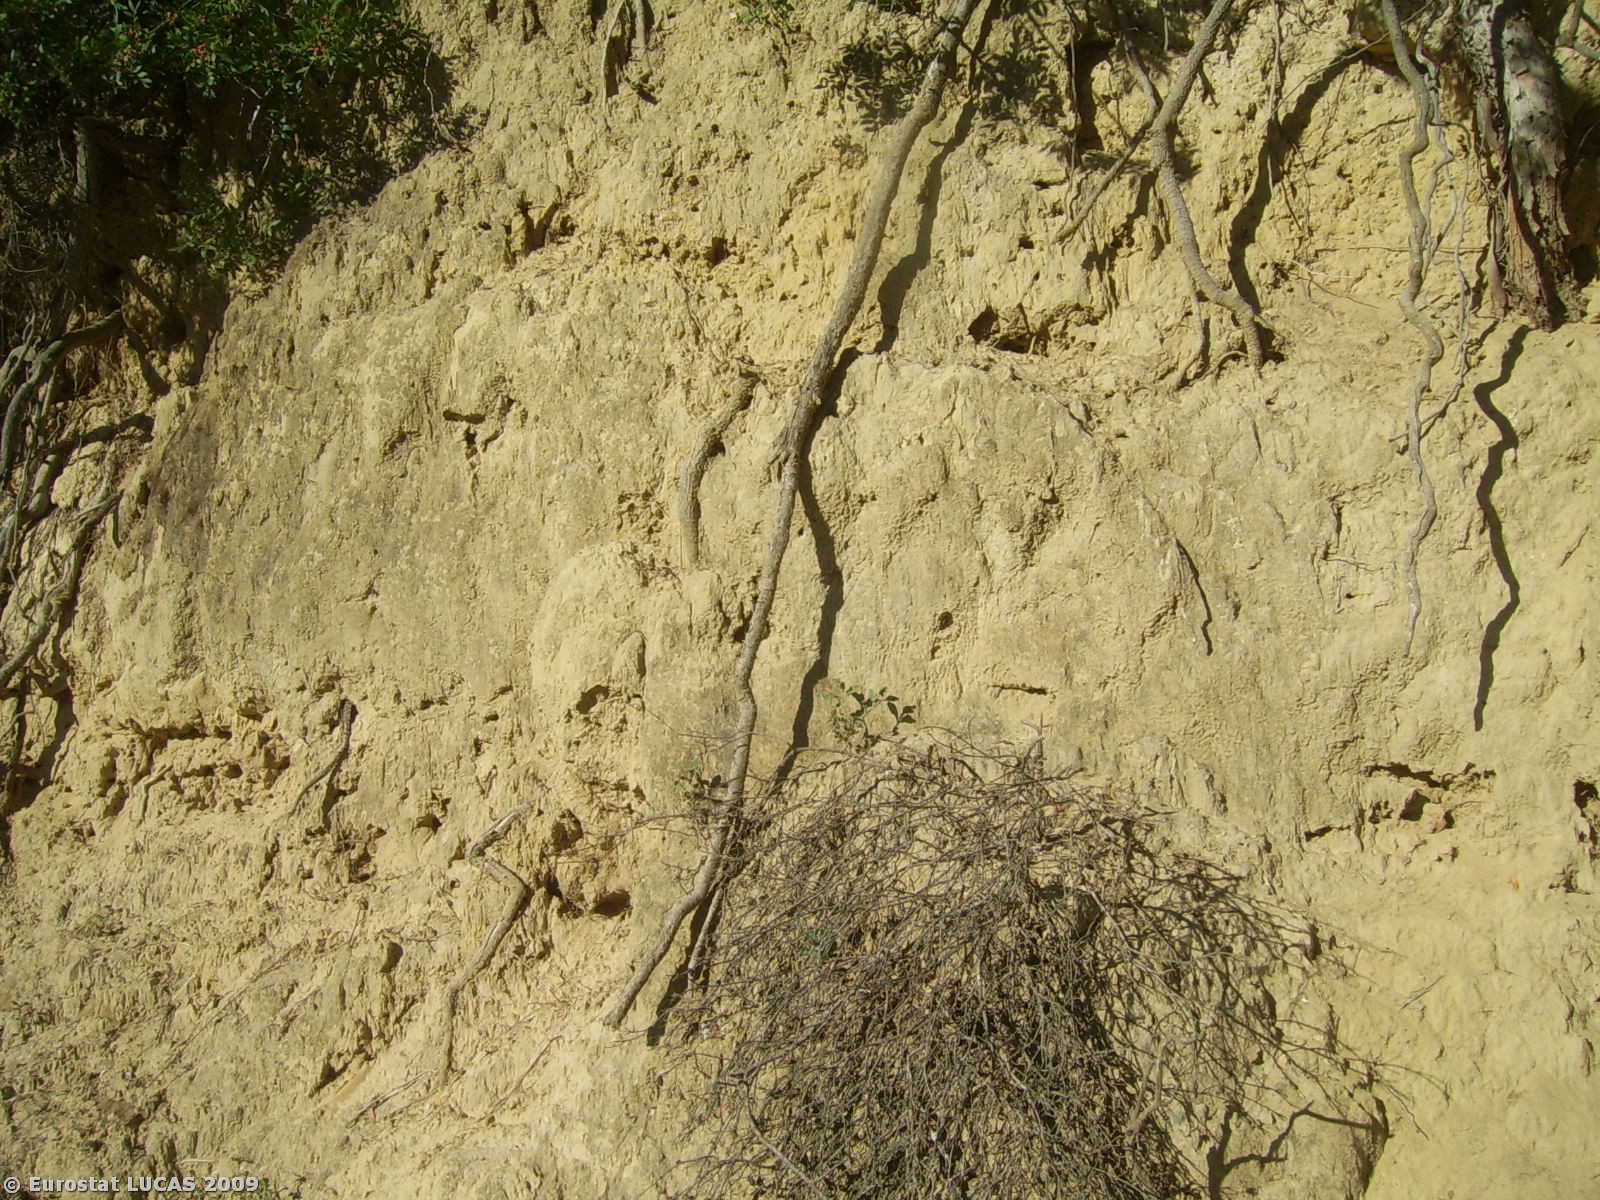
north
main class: Shrubland
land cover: Shrubland with sparse tree cover
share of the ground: > 75 %
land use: Unused
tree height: > 5 m
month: October
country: GR
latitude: 37.8817
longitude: 21.4104
